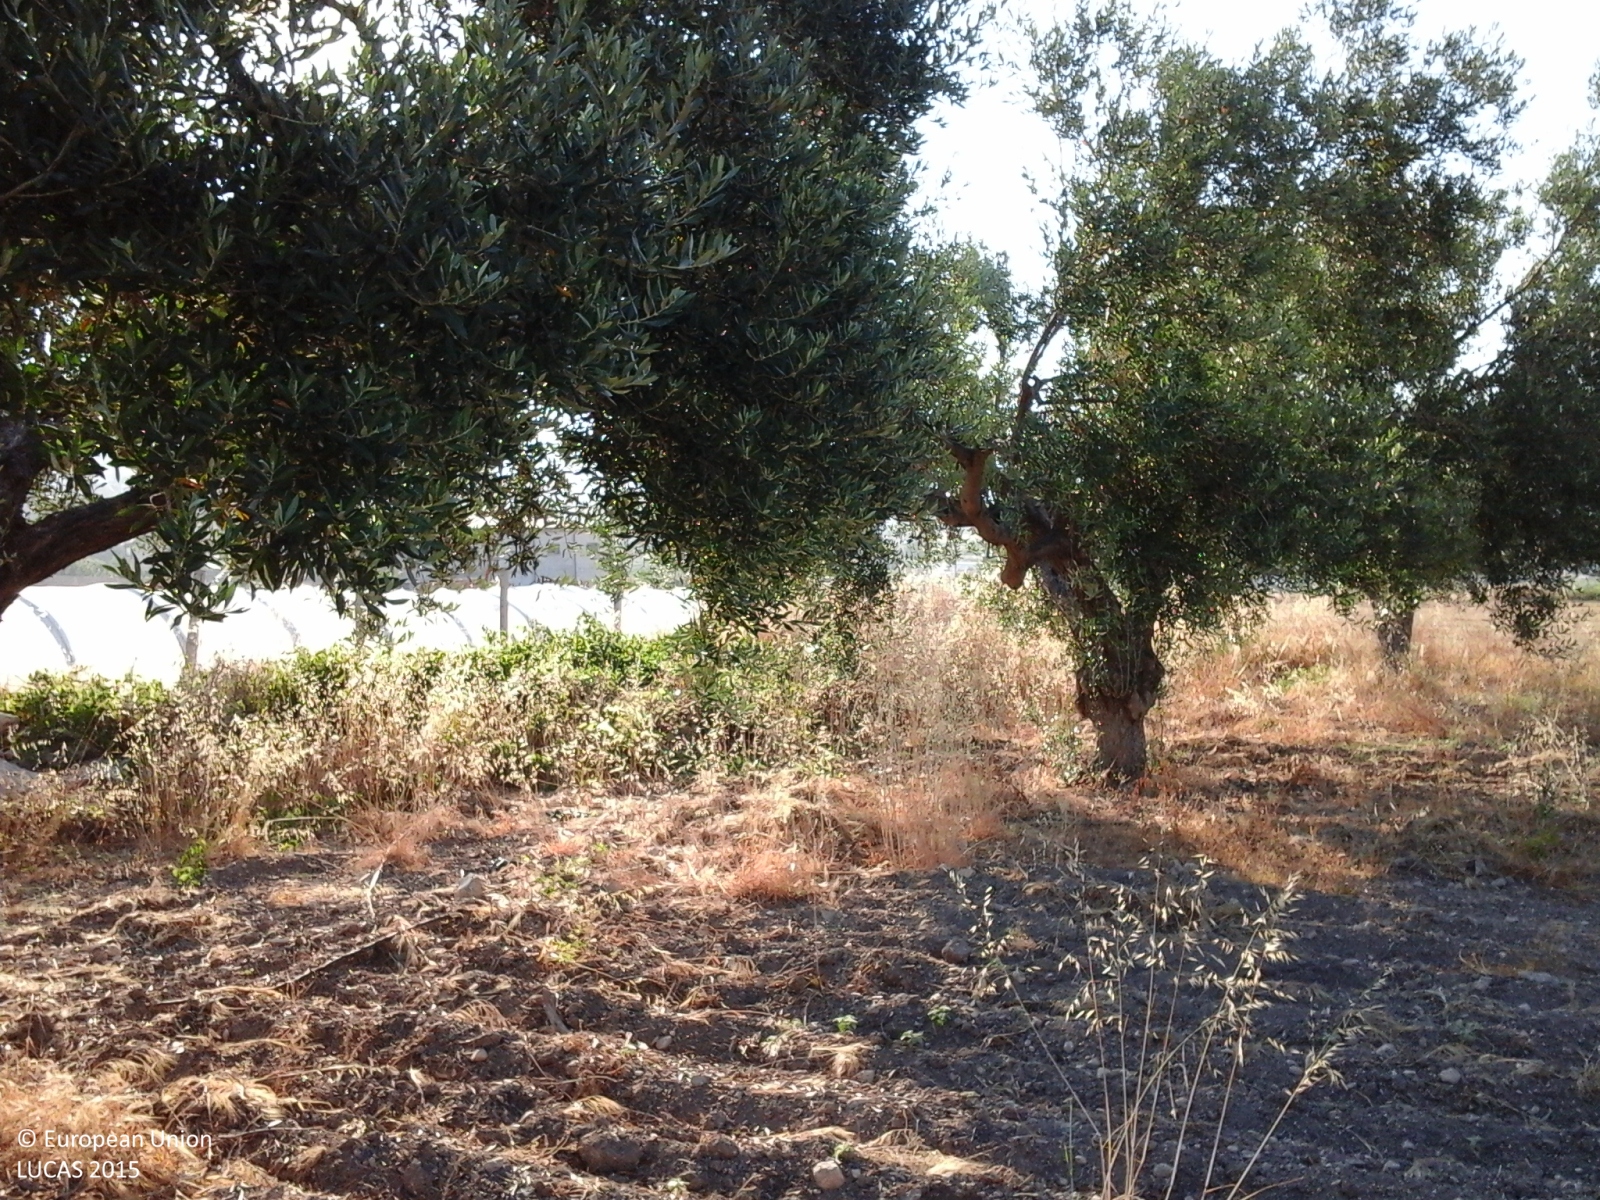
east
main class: Cropland
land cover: Olive groves
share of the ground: > 75 %
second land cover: Other bare soil
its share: > 75 %
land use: Agriculture (excluding fallow land and kitchen gardens)
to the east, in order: Olive groves; Other bare soil; Grass margins; Fences; Artificial constructions; Fences; Durum wheat; Artificial constructions in urban areas; Spontaneously vegetated surfaces; Fences; Olive groves; Tracks; Olive groves; Fences; Tracks; Fences; Olive groves; Fences; Tomatoes
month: July
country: IT
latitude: 37.1822
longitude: 13.7662
